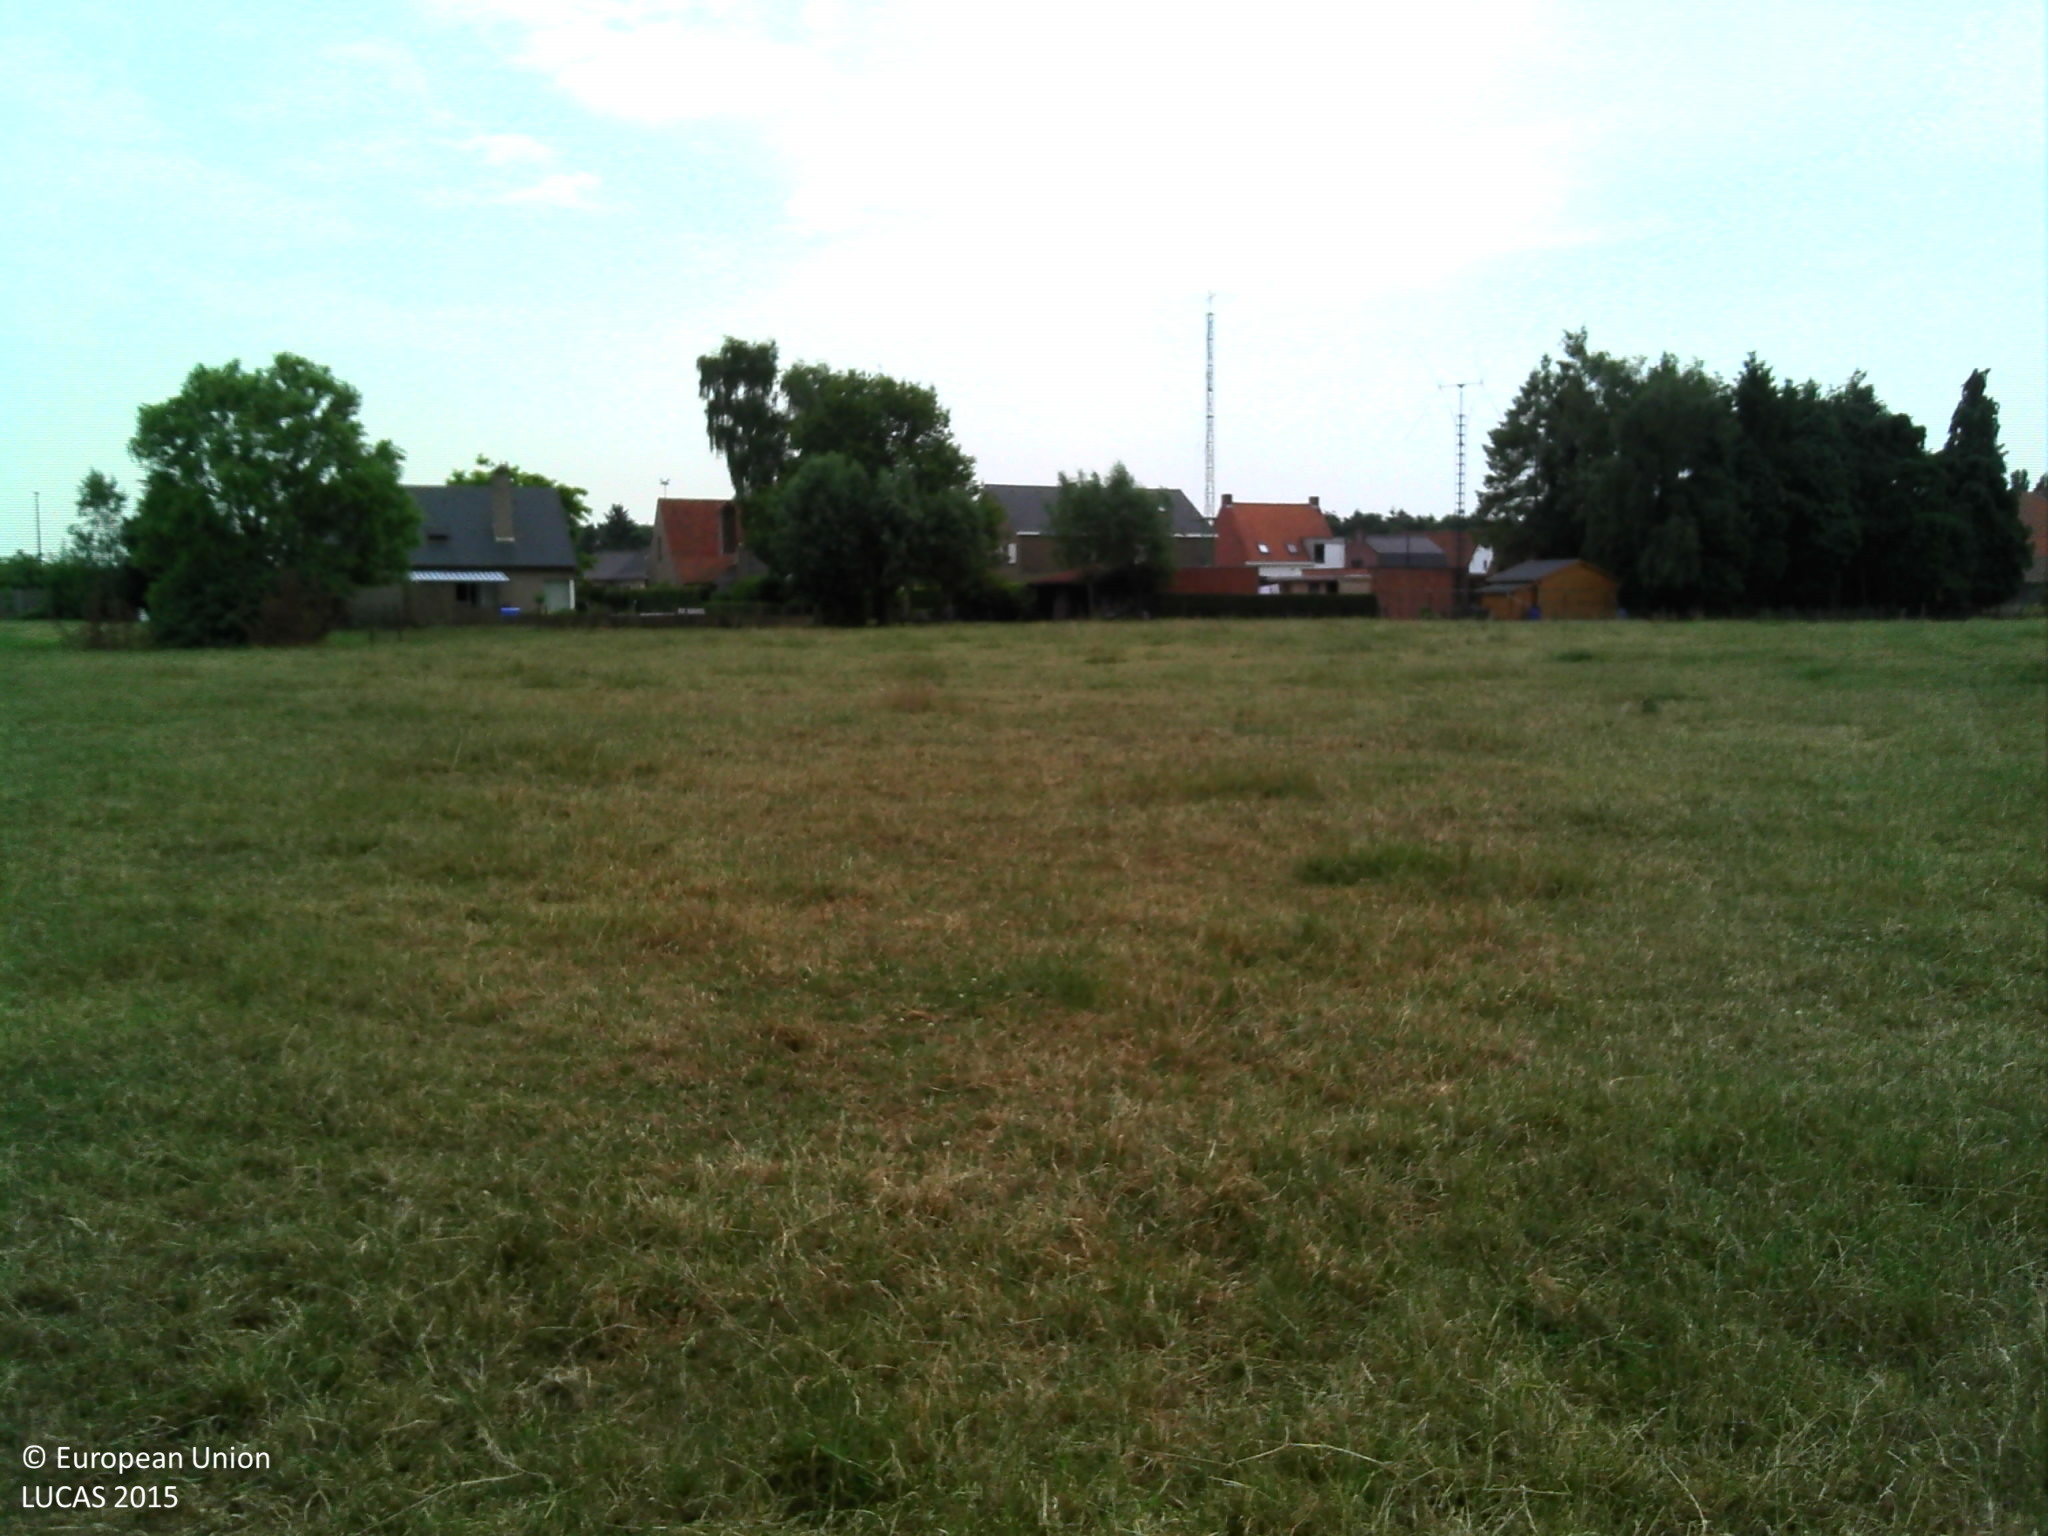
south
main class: Grassland
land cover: Grassland without tree/shrub cover
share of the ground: > 75 %
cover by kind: herbaceous plants 100 %
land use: Agriculture (excluding fallow land and kitchen gardens)
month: July
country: BE
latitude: 51.2452
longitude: 3.5315
